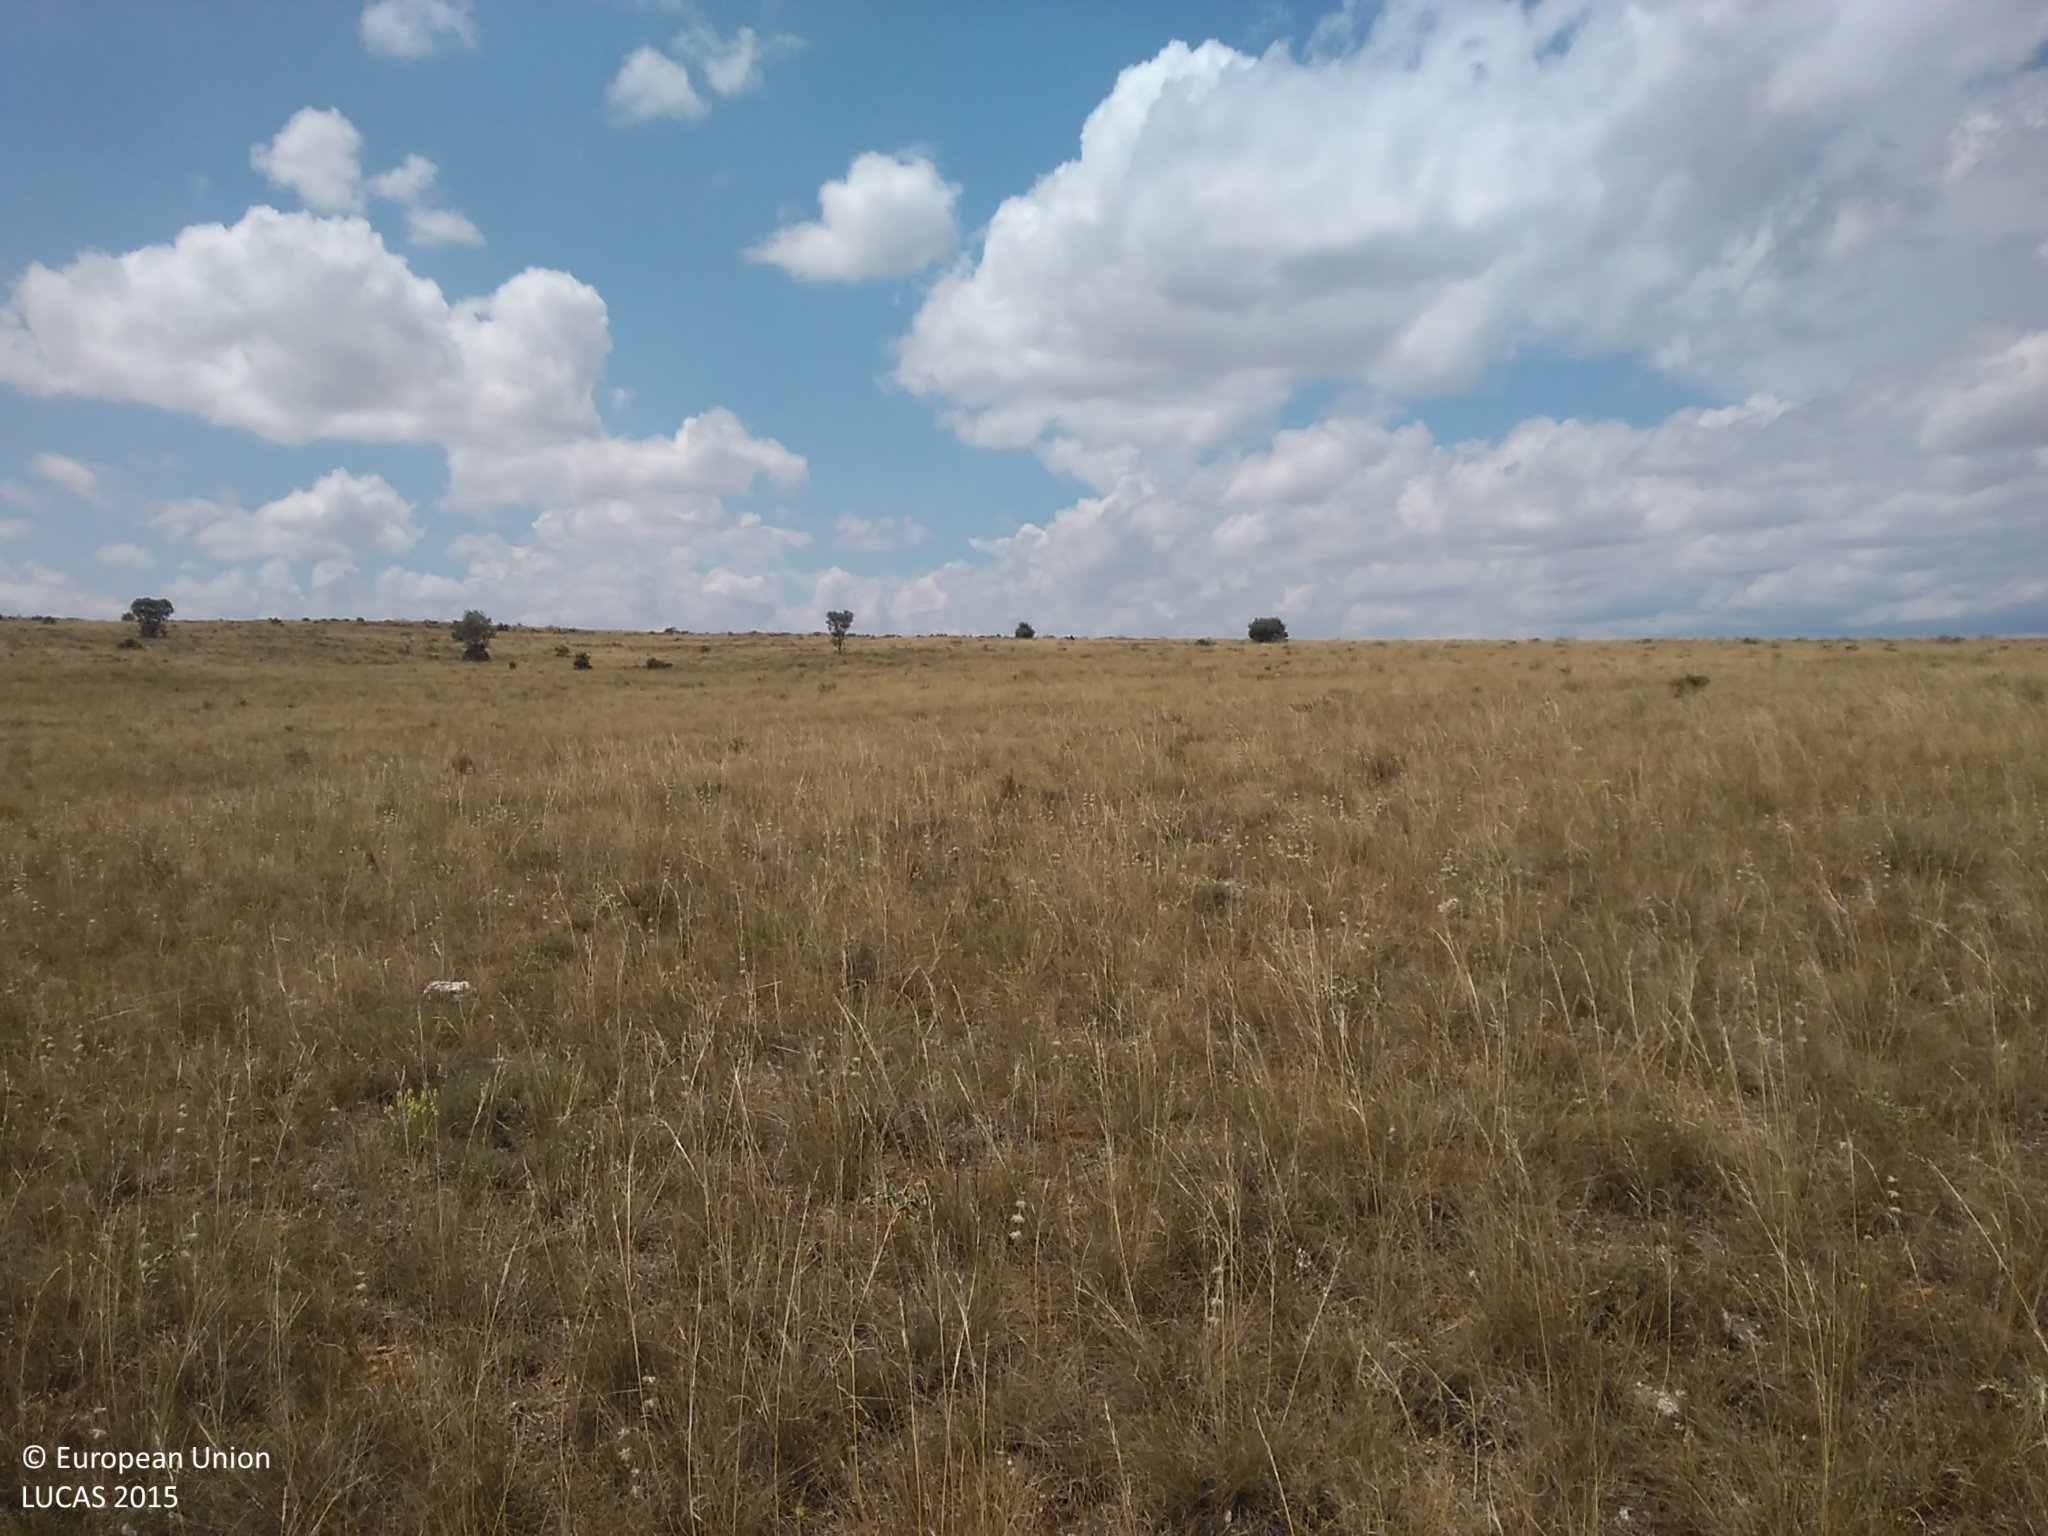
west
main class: Grassland
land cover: Grassland with sparse tree/shrub cover
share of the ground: 10 - 25 %
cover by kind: herbaceous plants 70 %, unconsolidated bare surface 20 %, broadleaved forest trees 5 %, shrubs 5 %
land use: Semi-natural and natural areas not in use
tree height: < 5 m
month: July
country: ES
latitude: 41.7741
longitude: -2.2950
